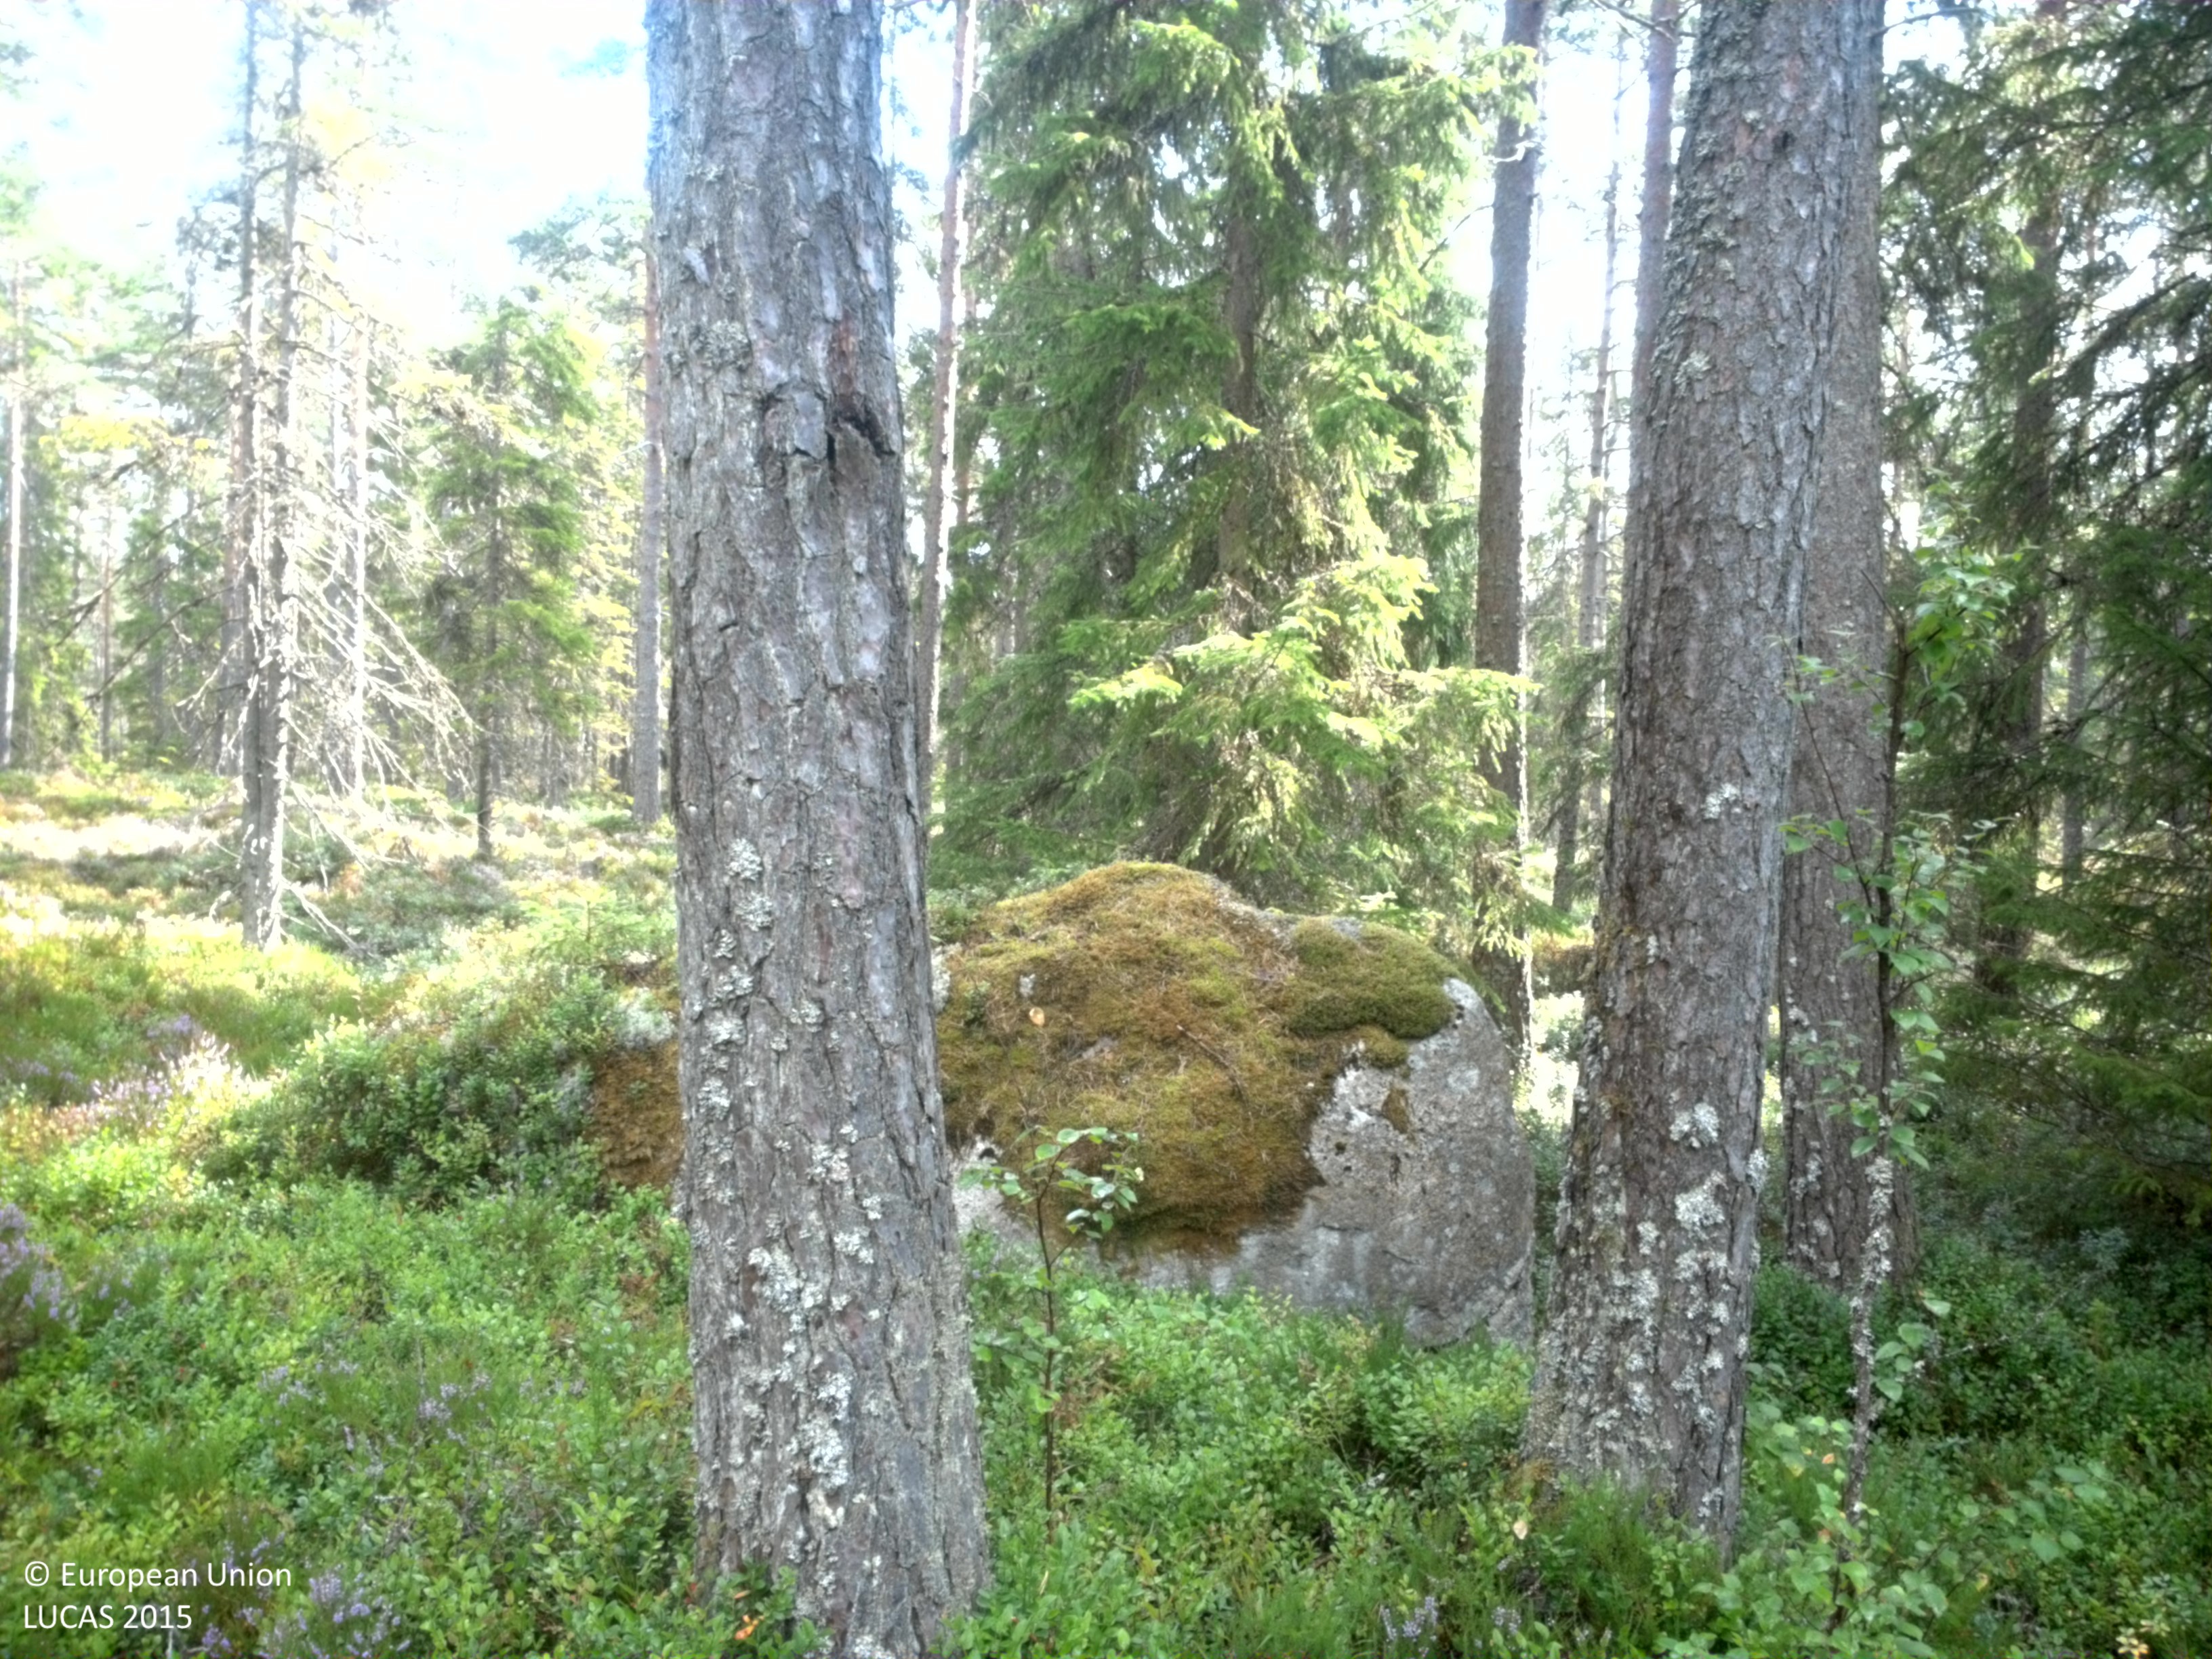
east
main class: Woodland
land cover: Pine dominated coniferous woodland
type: boreal forest
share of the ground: 25 - 50 %
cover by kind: shrubs 60 %, coniferous forest trees 40 %
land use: Forestry
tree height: > 5 m
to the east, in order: Pine dominated coniferous woodland; Spruce dominated coniferous woodland; Pine dominated coniferous woodland; Rivers and streams; Pine dominated coniferous woodland
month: August
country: SE
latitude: 57.9809
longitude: 13.9685
